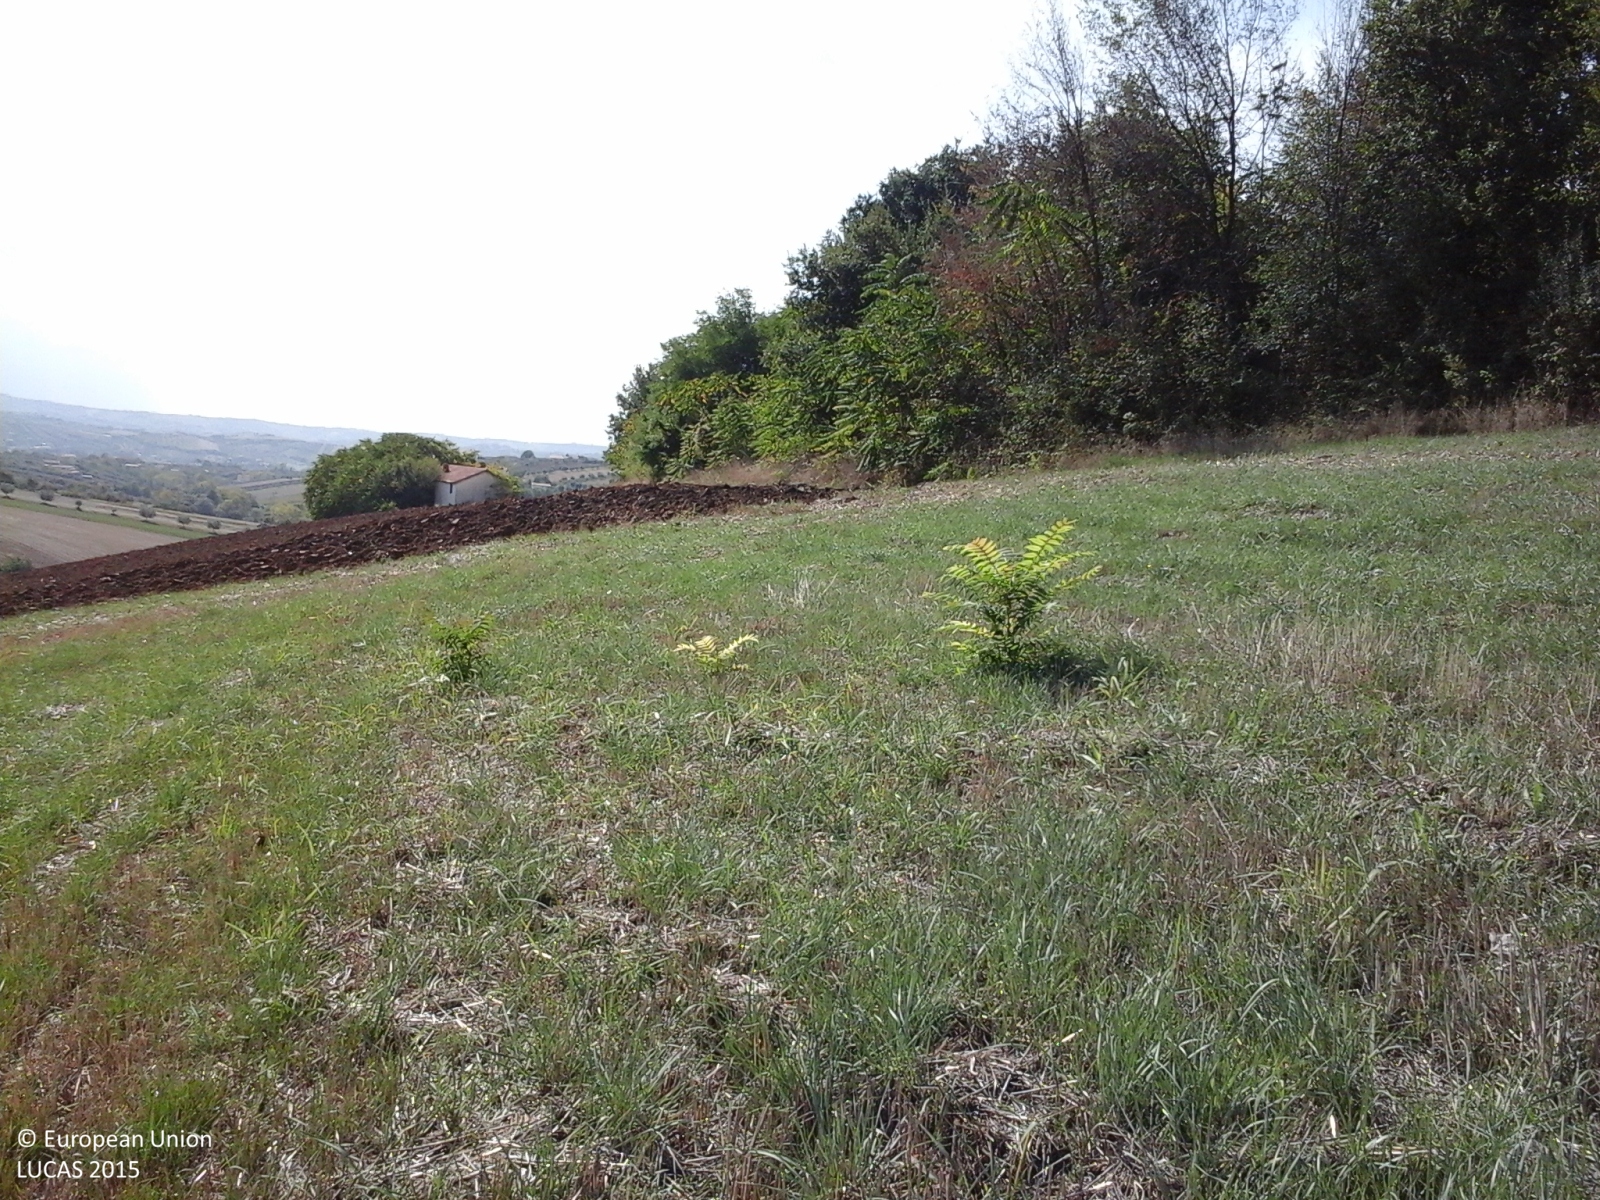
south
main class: Cropland
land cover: Common wheat
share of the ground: > 75 %
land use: Agriculture (excluding fallow land and kitchen gardens)
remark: Harvested field
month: September
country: IT
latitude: 42.8522
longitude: 13.8442
